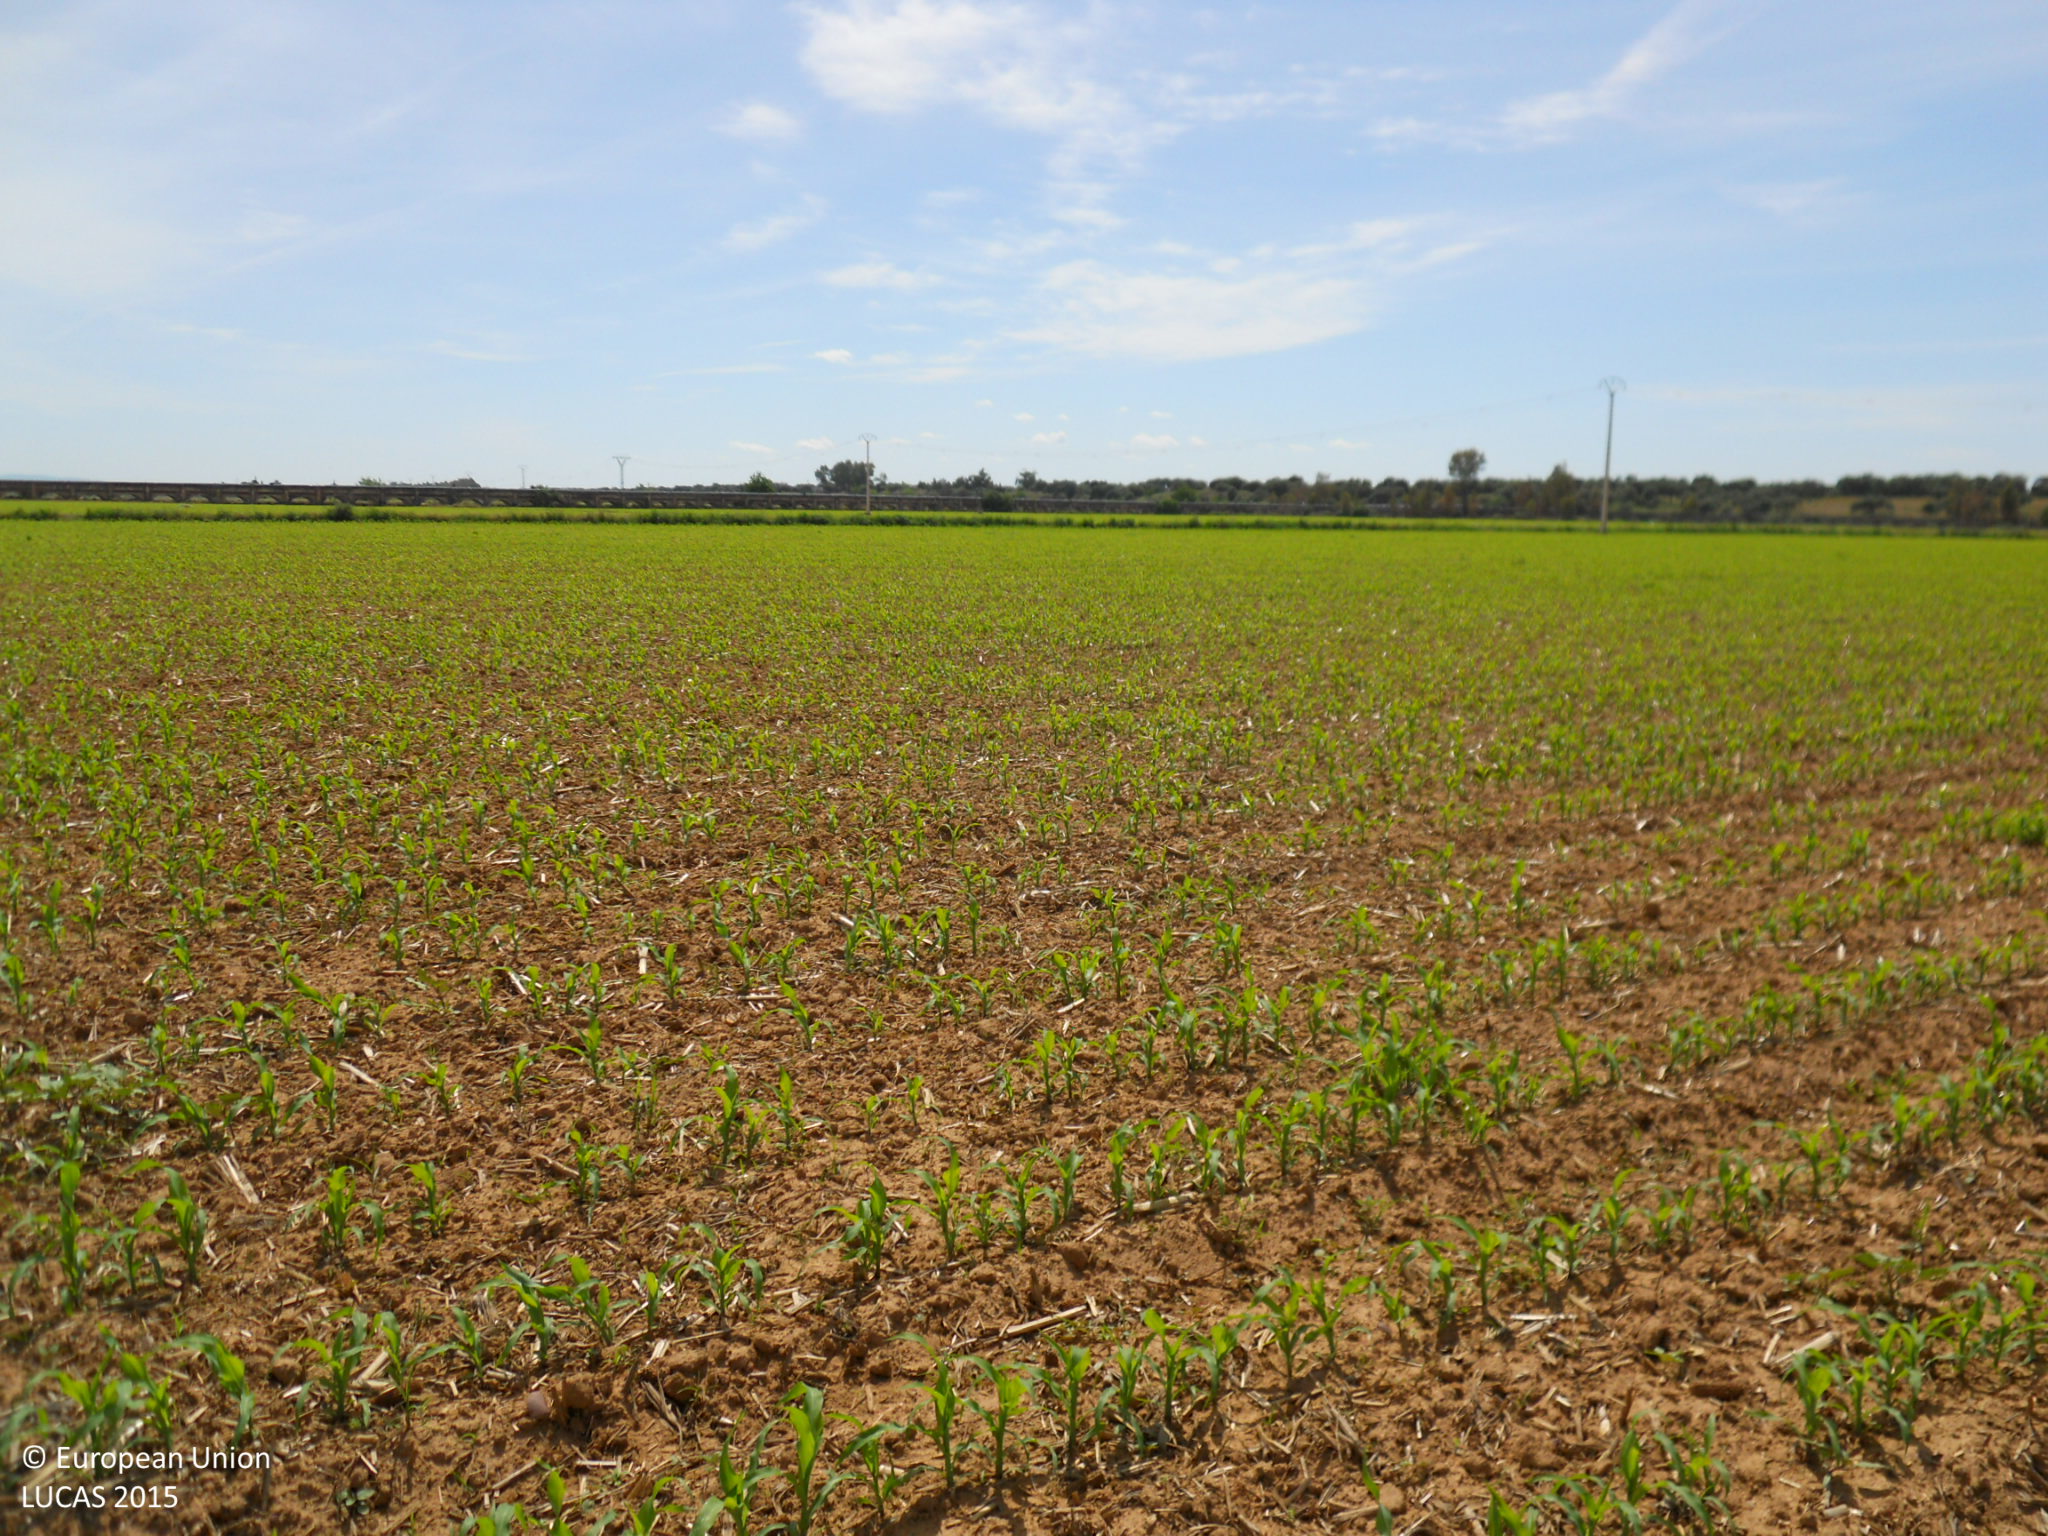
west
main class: Cropland
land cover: Maize
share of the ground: 10 - 25 %
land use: Agriculture (excluding fallow land and kitchen gardens)
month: April
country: ES
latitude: 38.9678
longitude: -6.9327
